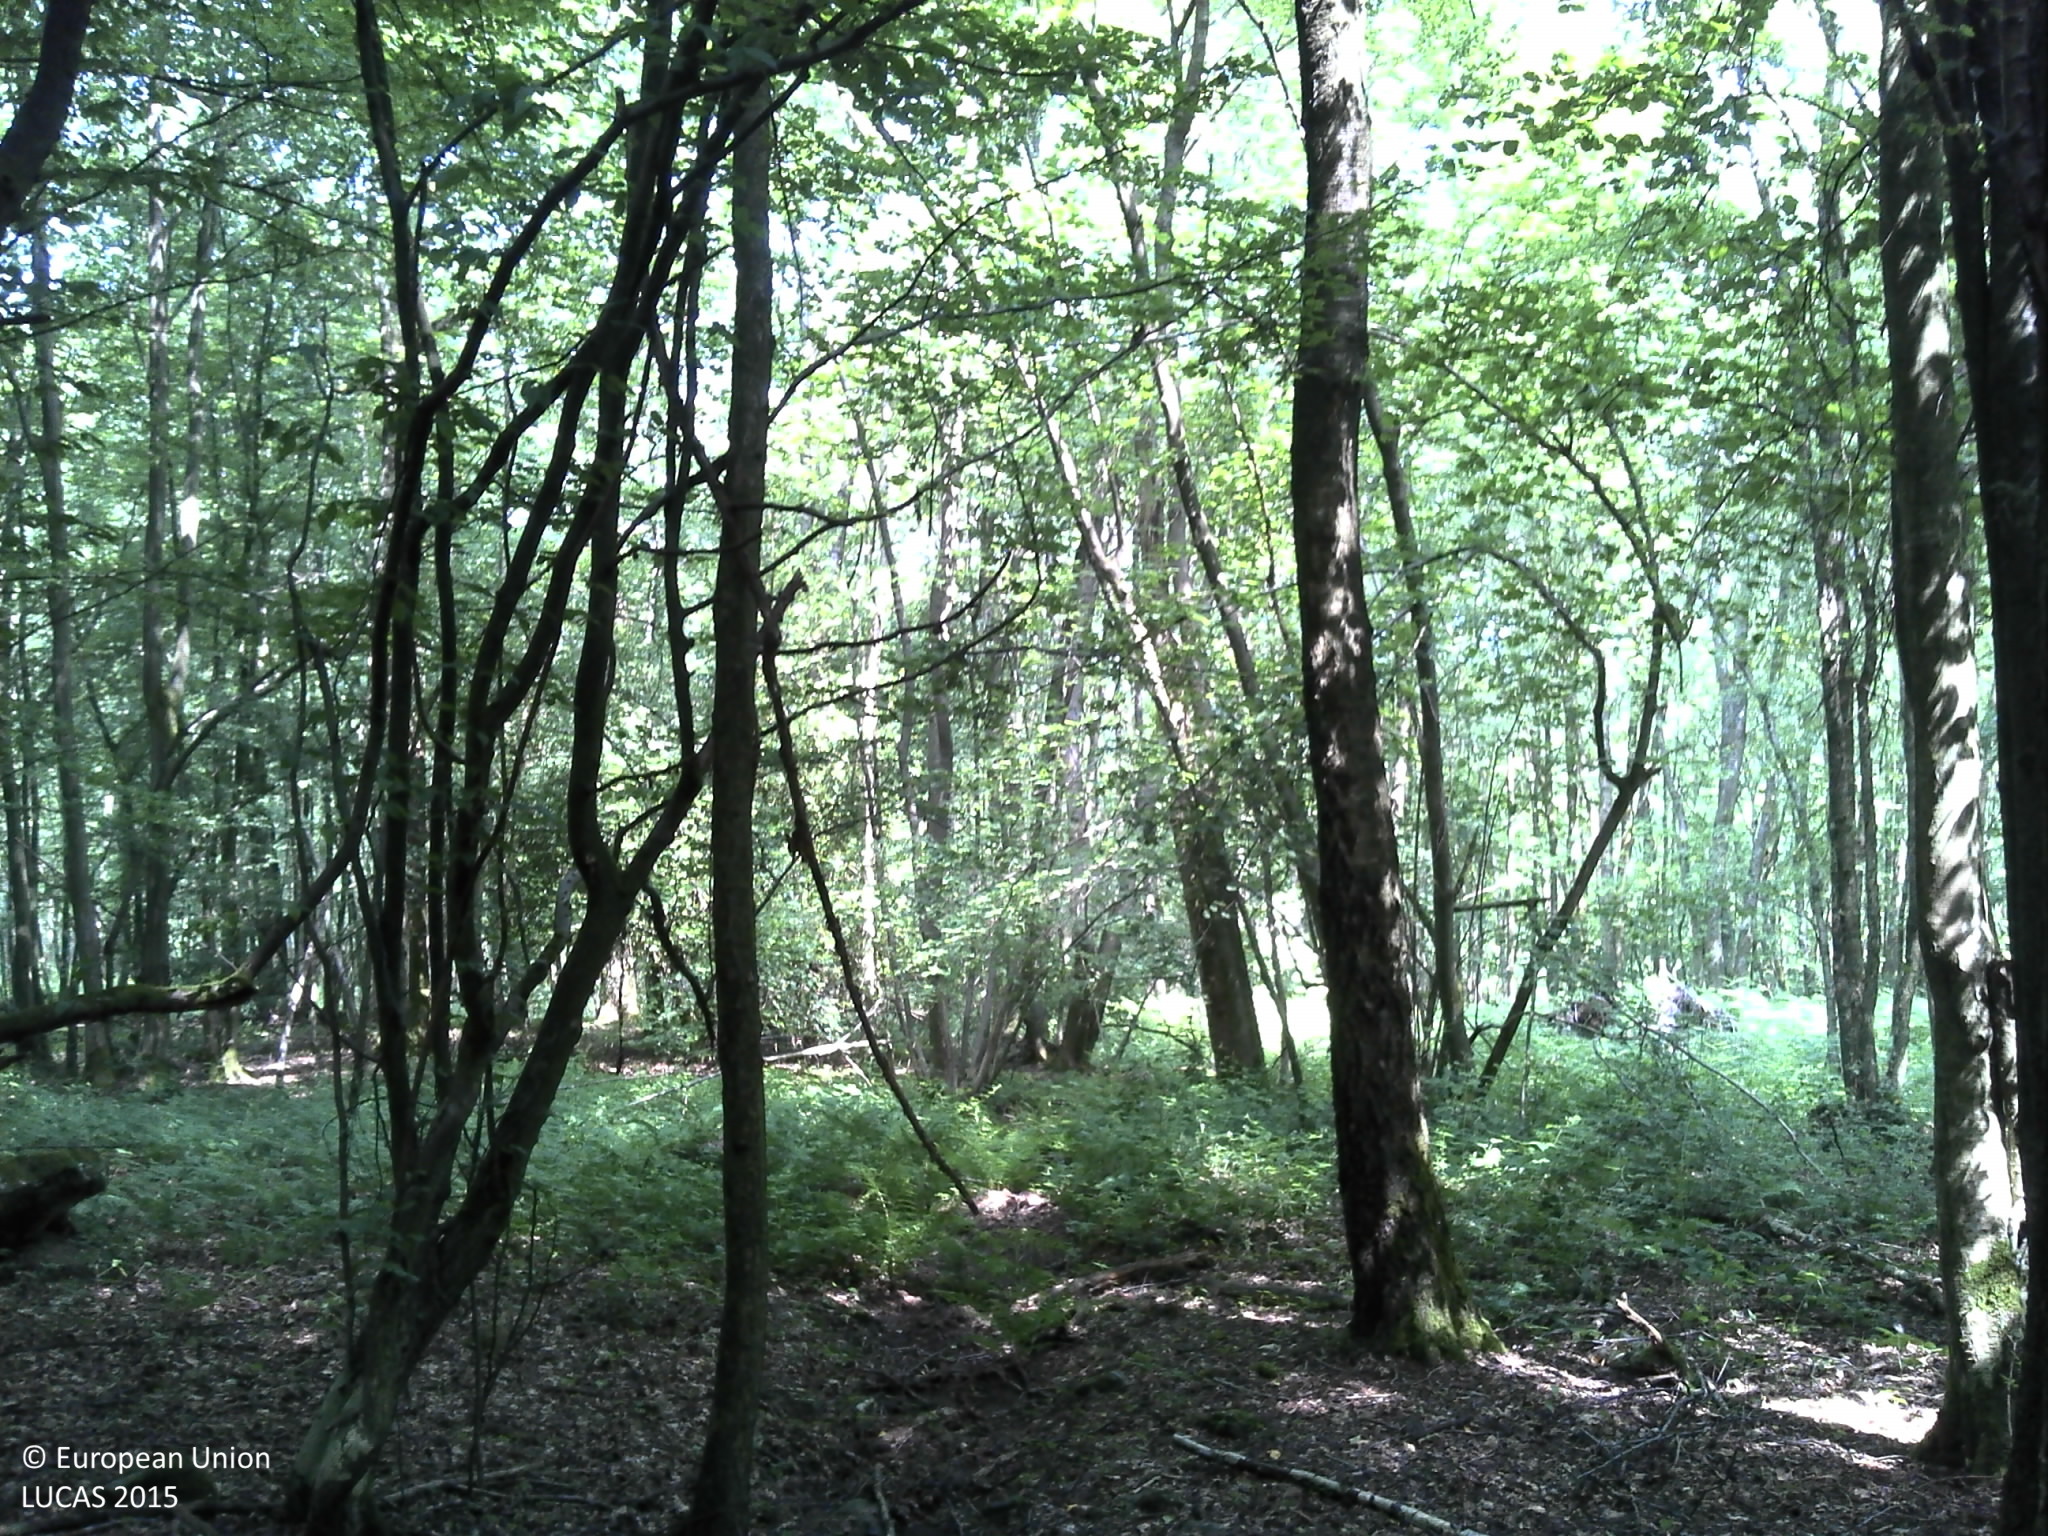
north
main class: Woodland
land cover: Broadleaved woodland
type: beech forest
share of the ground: 50 - 75 %
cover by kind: broadleaved forest trees 65 %, herbaceous plants 15 %, consolidated bare surface 15 %, lichens and mosses 5 %
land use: Forestry
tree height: > 5 m
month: July
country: FR
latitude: 49.9523
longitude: 4.6864
